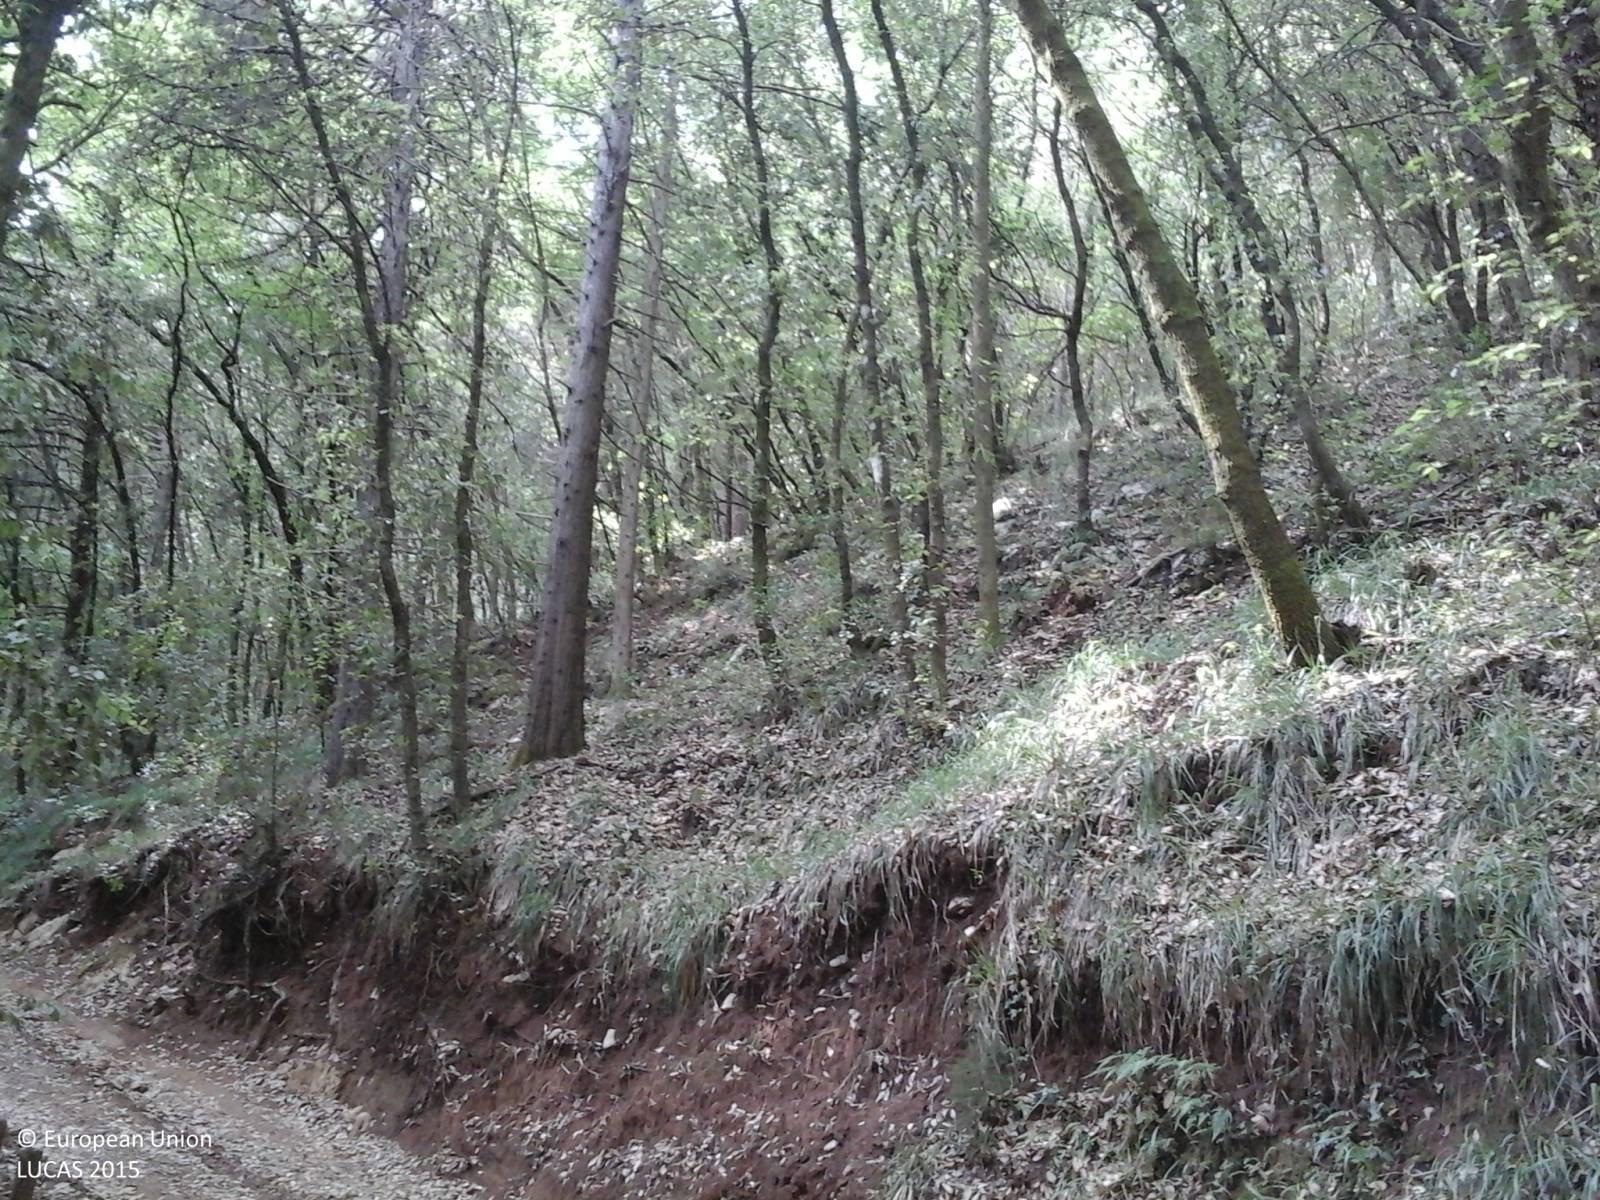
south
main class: Woodland
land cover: Broadleaved woodland
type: thermophilous deciduous forest
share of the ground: > 75 %
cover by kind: broadleaved forest trees 90 %, coniferous forest trees 10 %
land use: Forestry
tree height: < 5 m
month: June
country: IT
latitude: 41.1667
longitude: 13.9293
